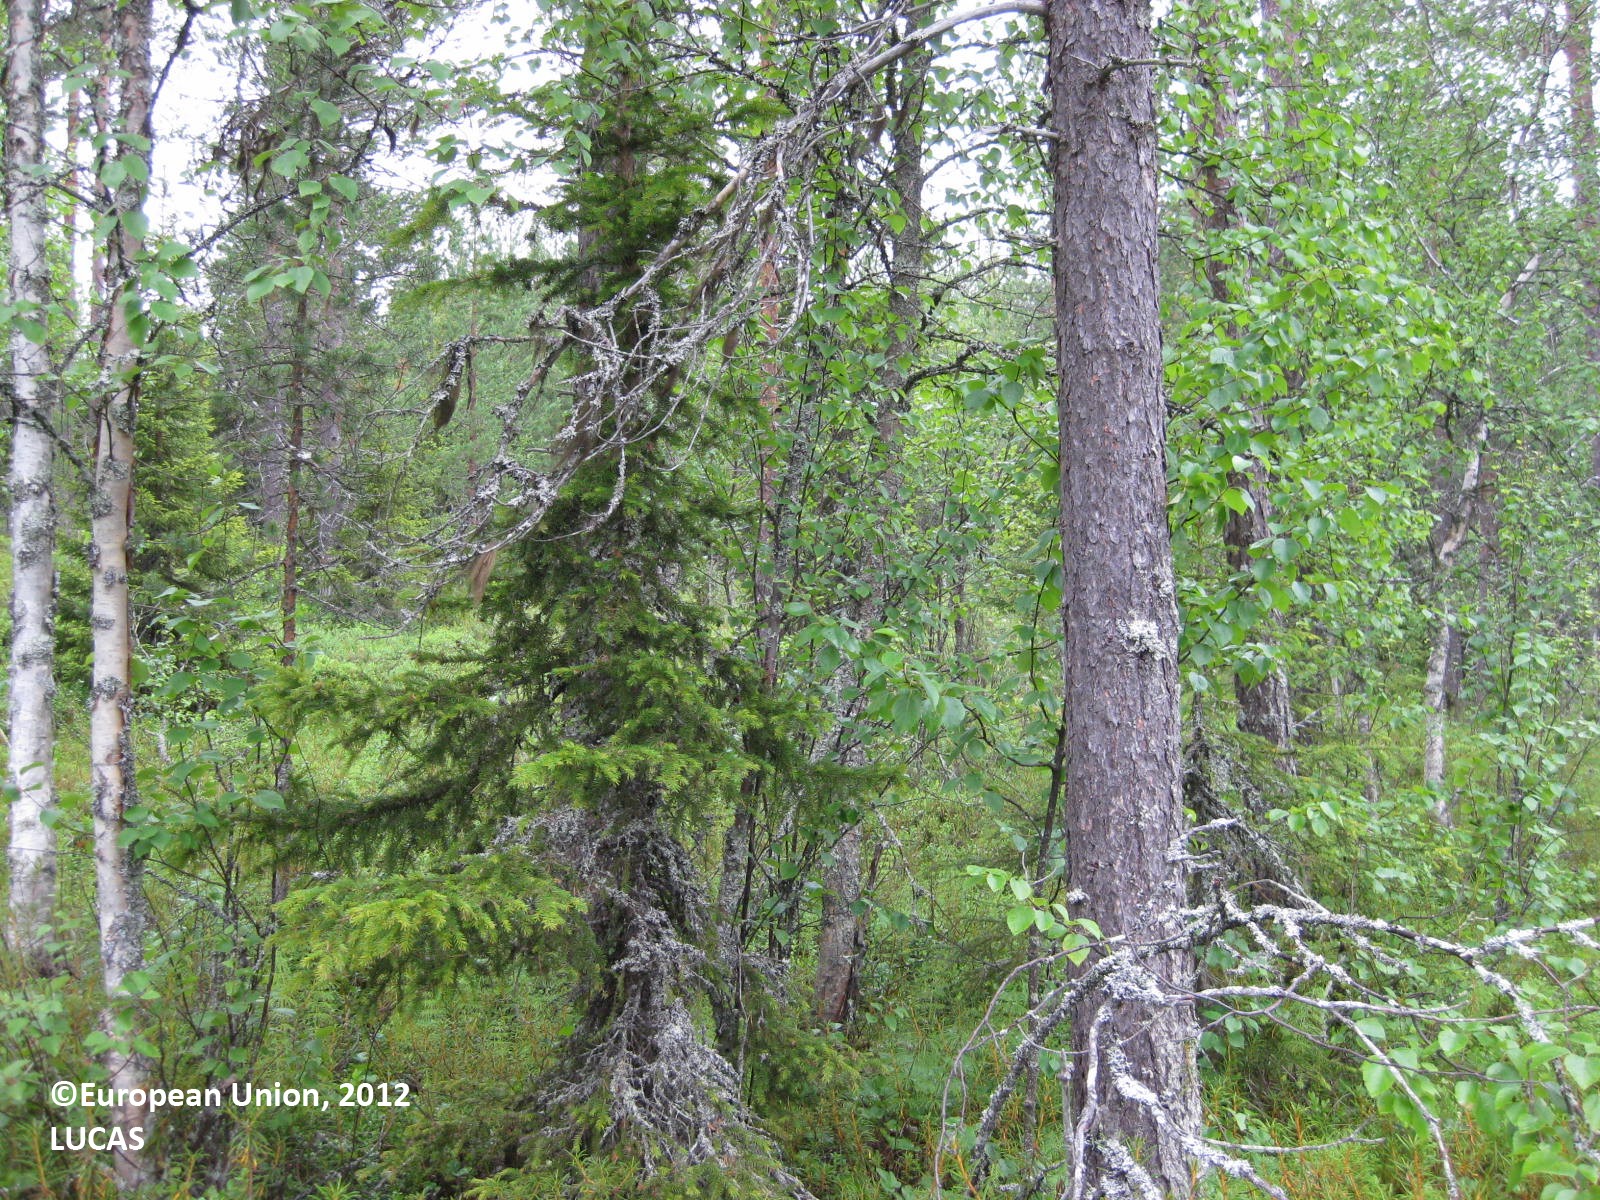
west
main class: Woodland
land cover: Pine dominated mixed woodland
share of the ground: 50 - 75 %
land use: Forestry
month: July
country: FI
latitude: 65.8414
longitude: 29.8945
